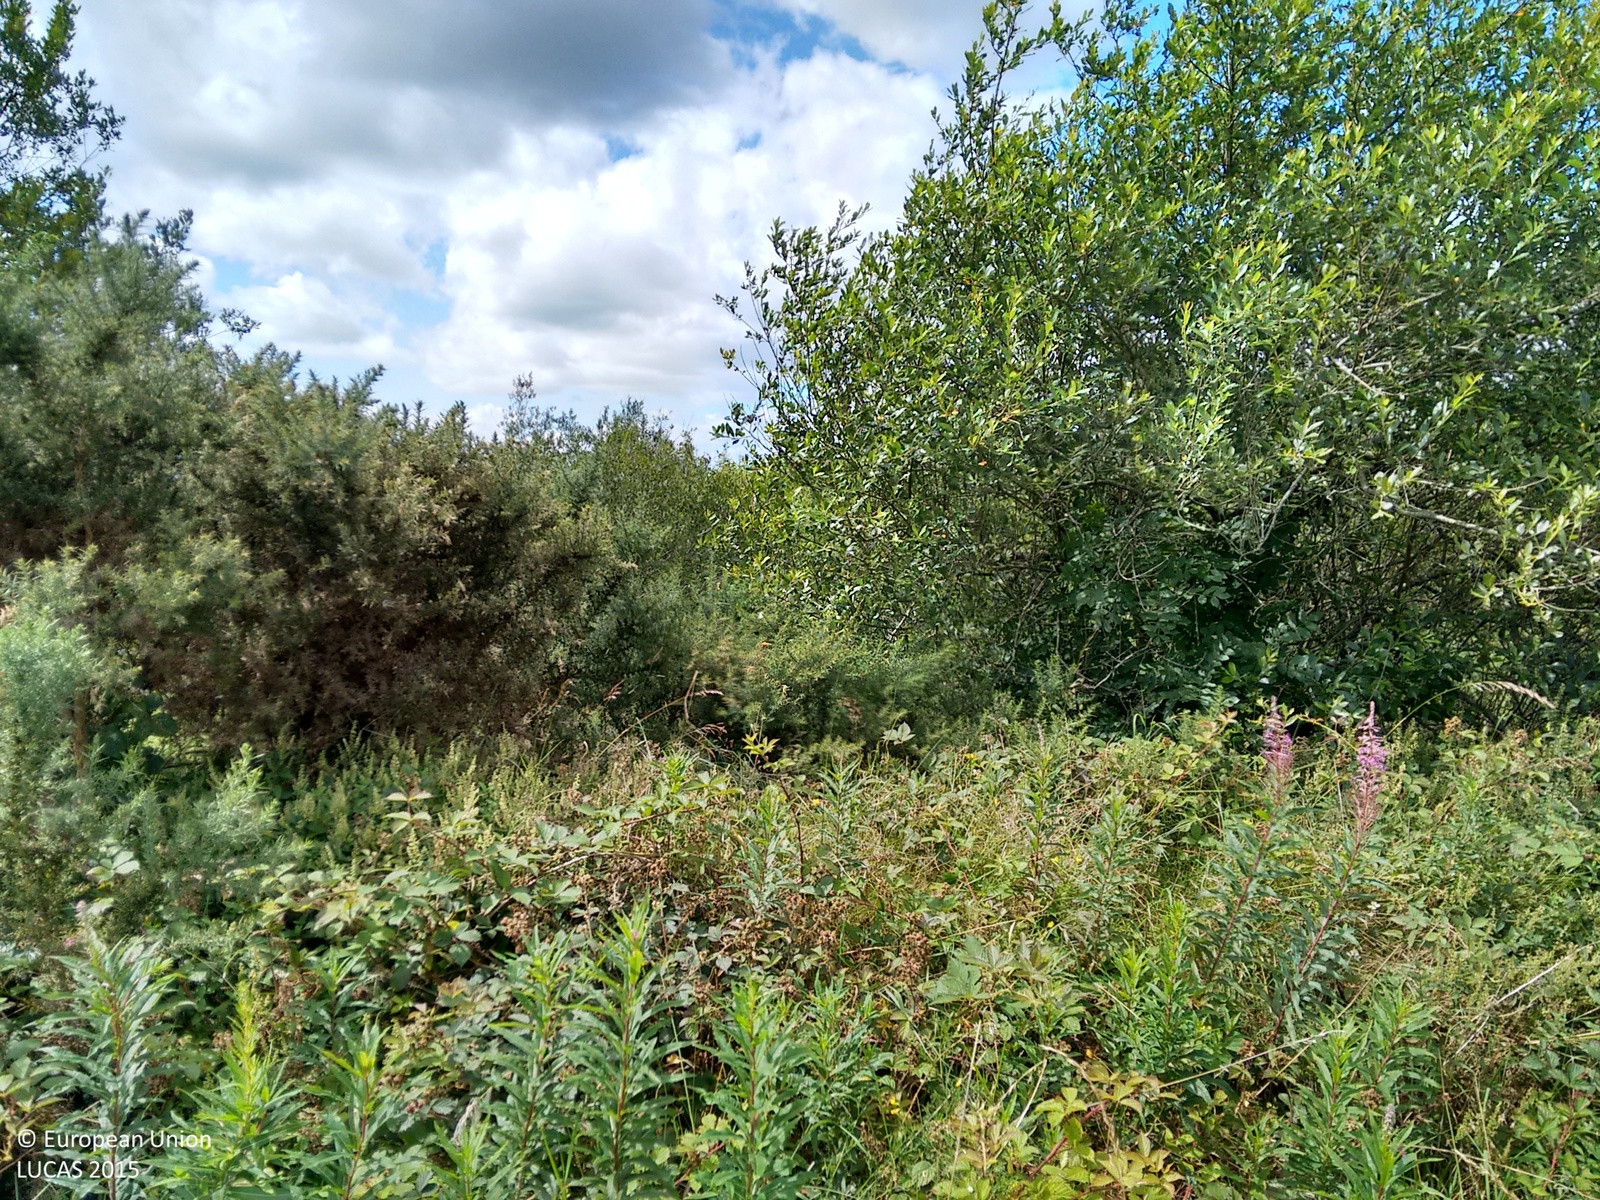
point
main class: Woodland
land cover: Other mixed woodland
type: exotic forest
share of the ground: > 75 %
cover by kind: coniferous forest trees 50 %, broadleaved forest trees 50 %
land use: Forestry
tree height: < 5 m
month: August
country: IE
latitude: 52.3728
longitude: -7.1115
